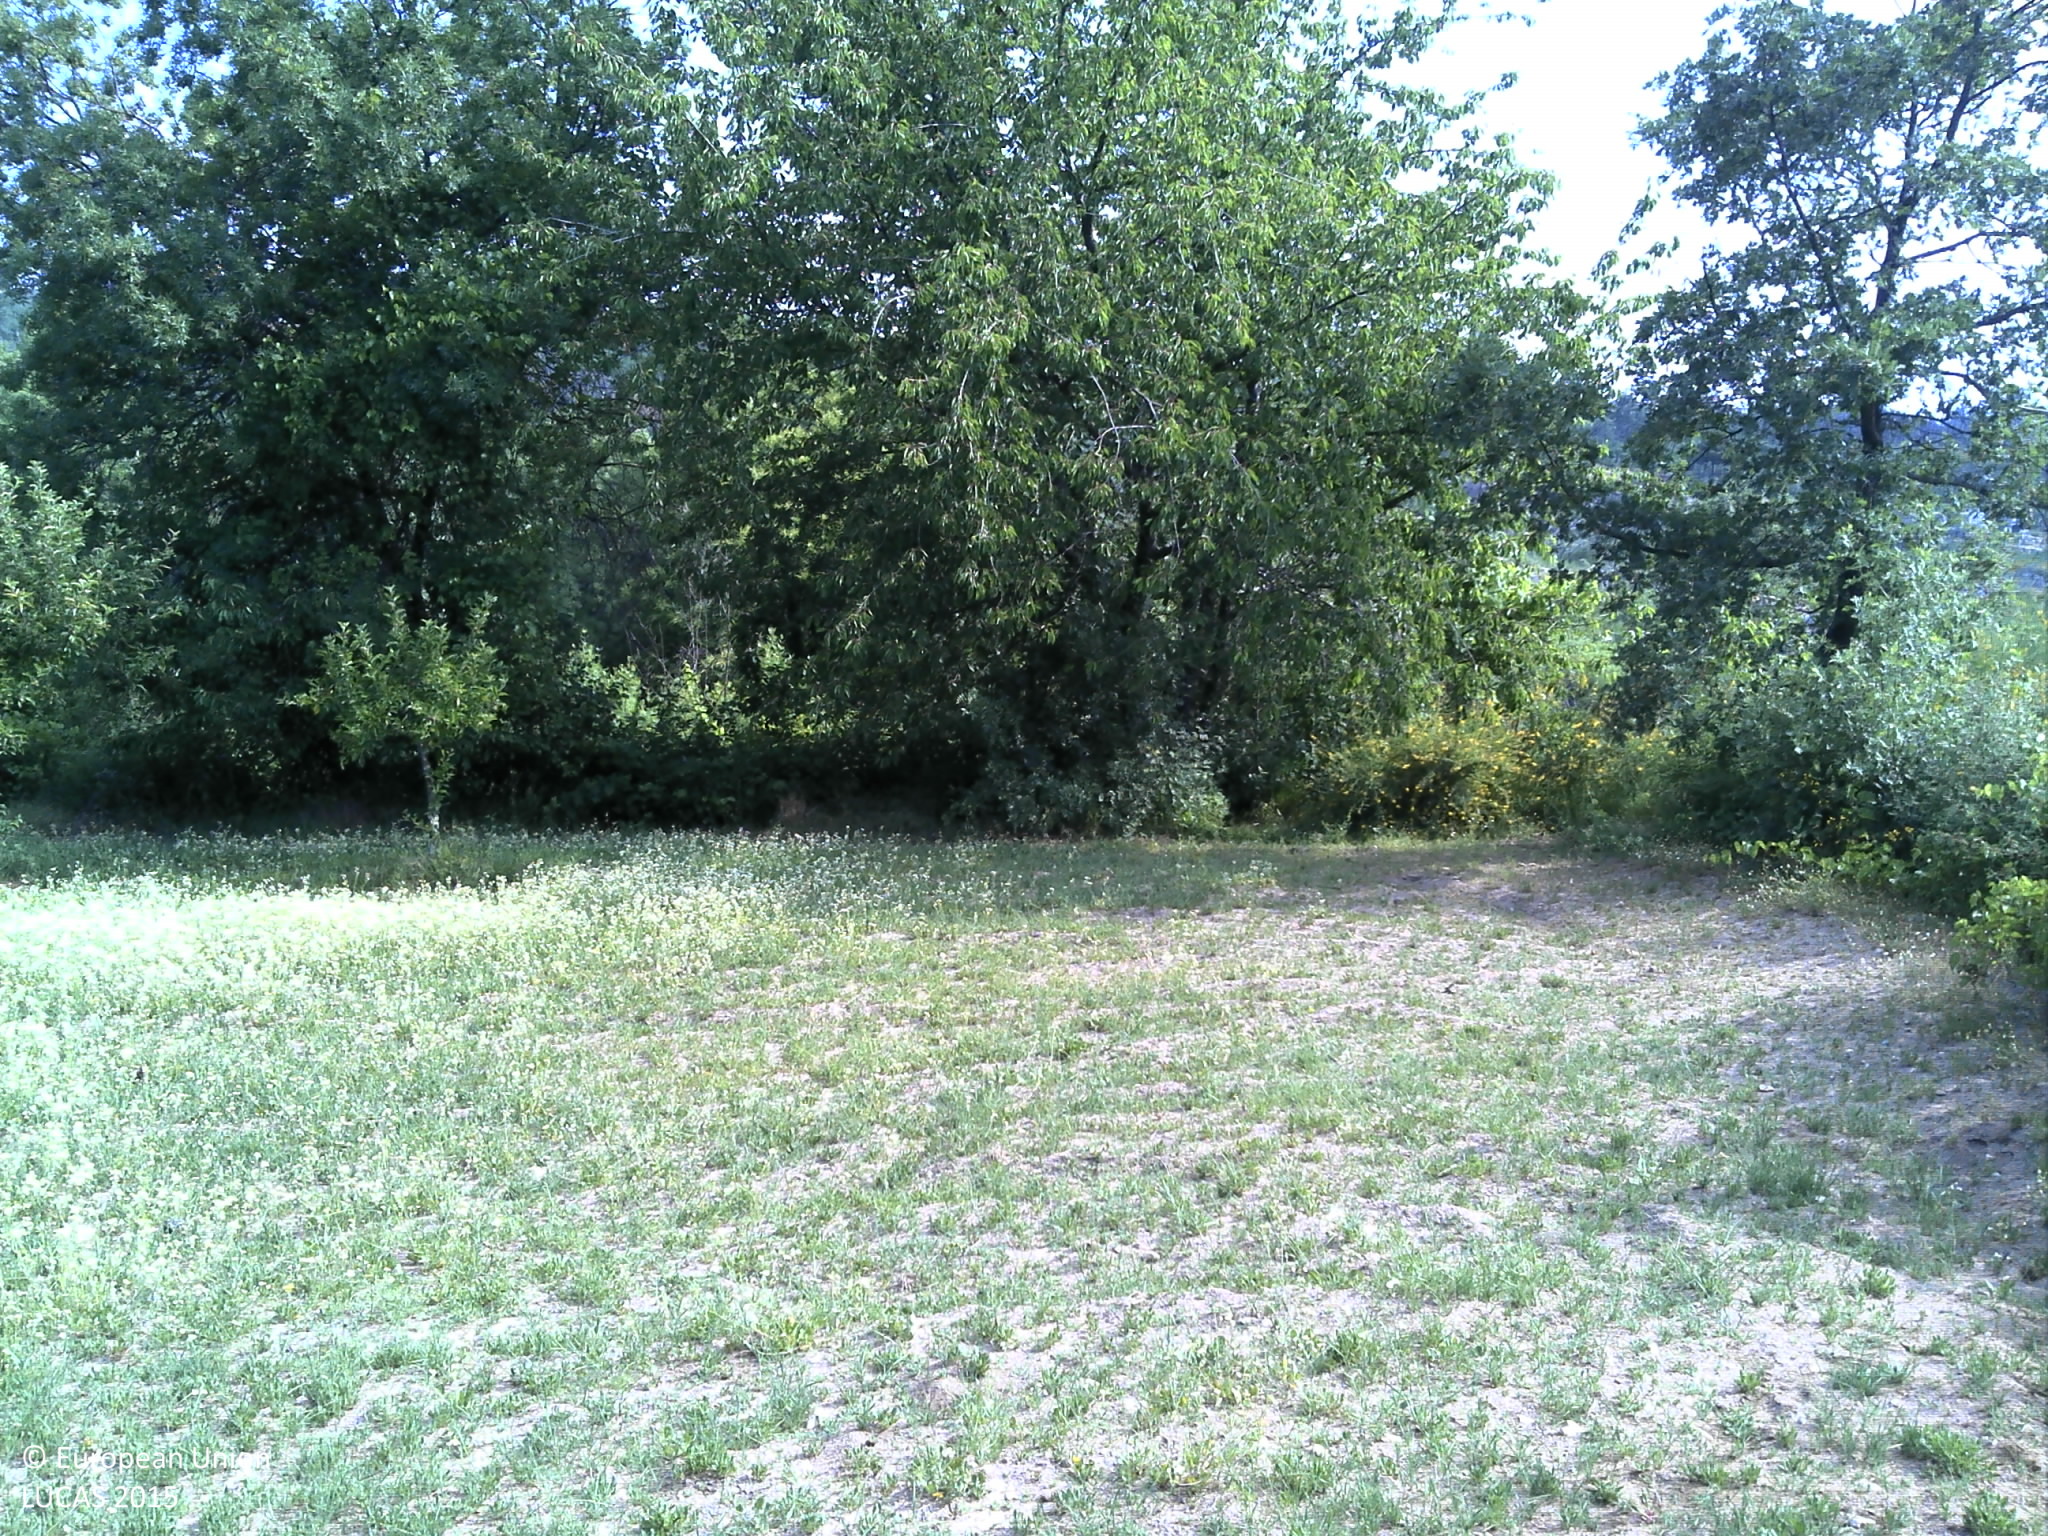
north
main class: Shrubland
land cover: Shrubland with sparse tree cover
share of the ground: > 75 %
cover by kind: shrubs 95 %, broadleaved forest trees 5 %
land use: Semi-natural and natural areas not in use
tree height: < 5 m
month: June
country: PT
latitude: 41.3190
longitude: -7.6045
